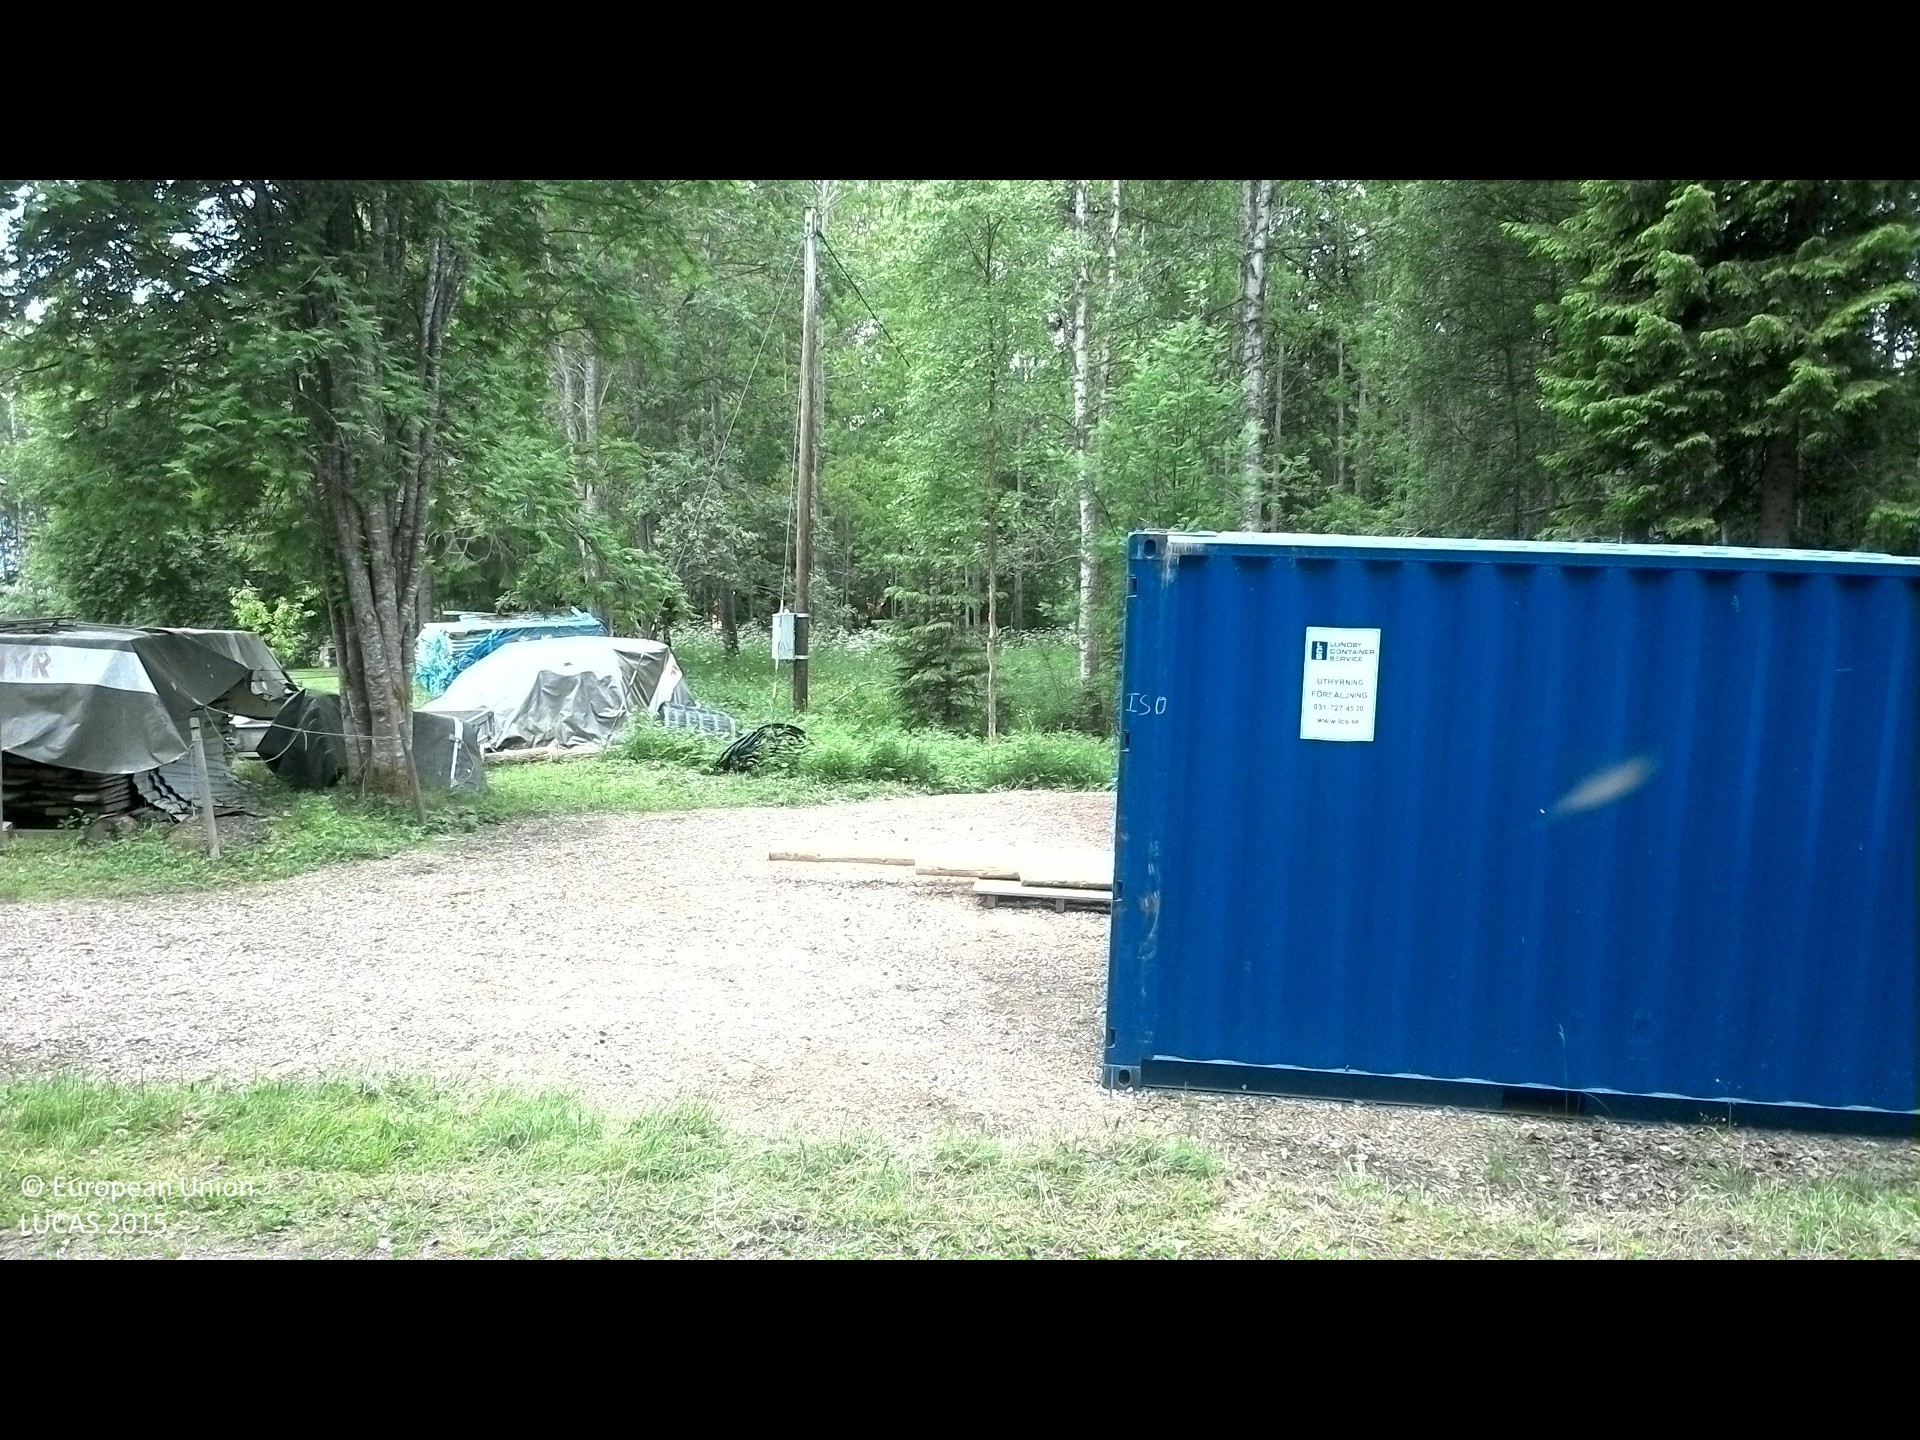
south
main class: Grassland
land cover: Grassland without tree/shrub cover
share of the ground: > 75 %
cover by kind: herbaceous plants 100 %
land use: Residential
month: June
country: SE
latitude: 62.0426
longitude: 16.3868
